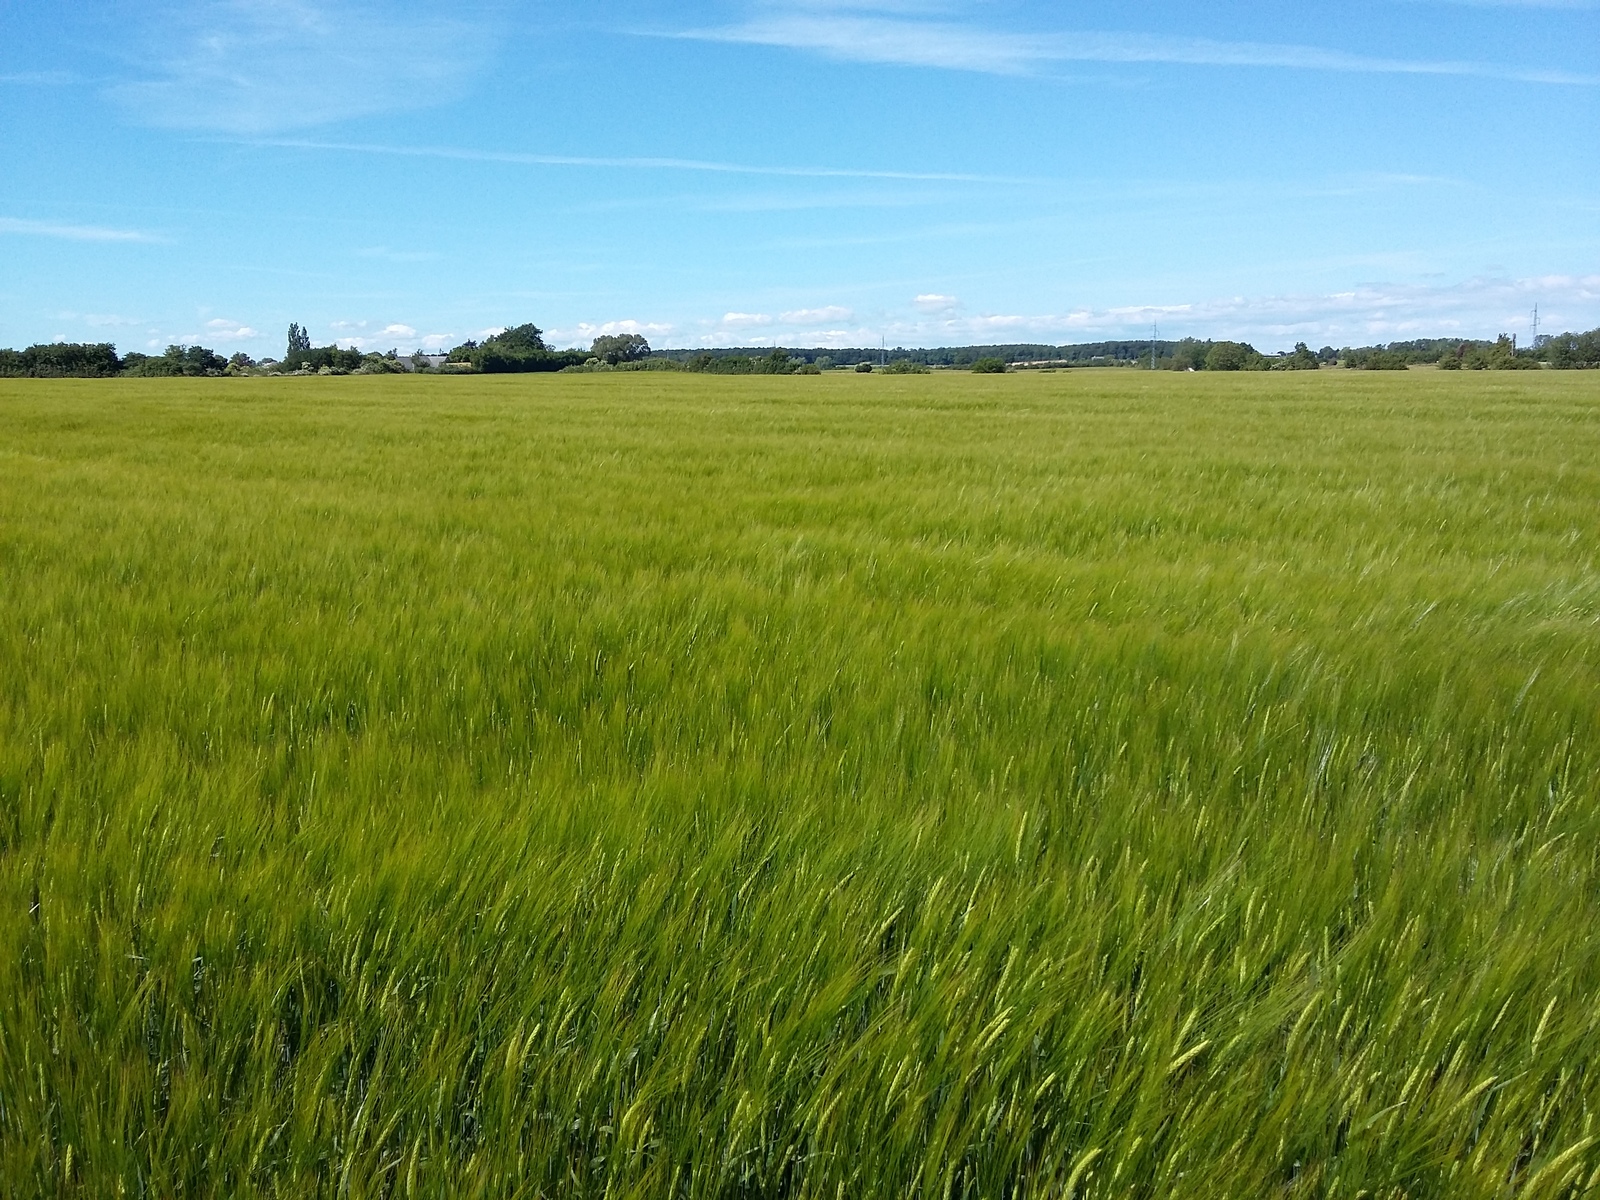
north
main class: Cropland
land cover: Barley
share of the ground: > 75 %
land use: Agriculture (excluding fallow land and kitchen gardens)
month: June
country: DK
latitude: 54.8614
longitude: 11.8839
